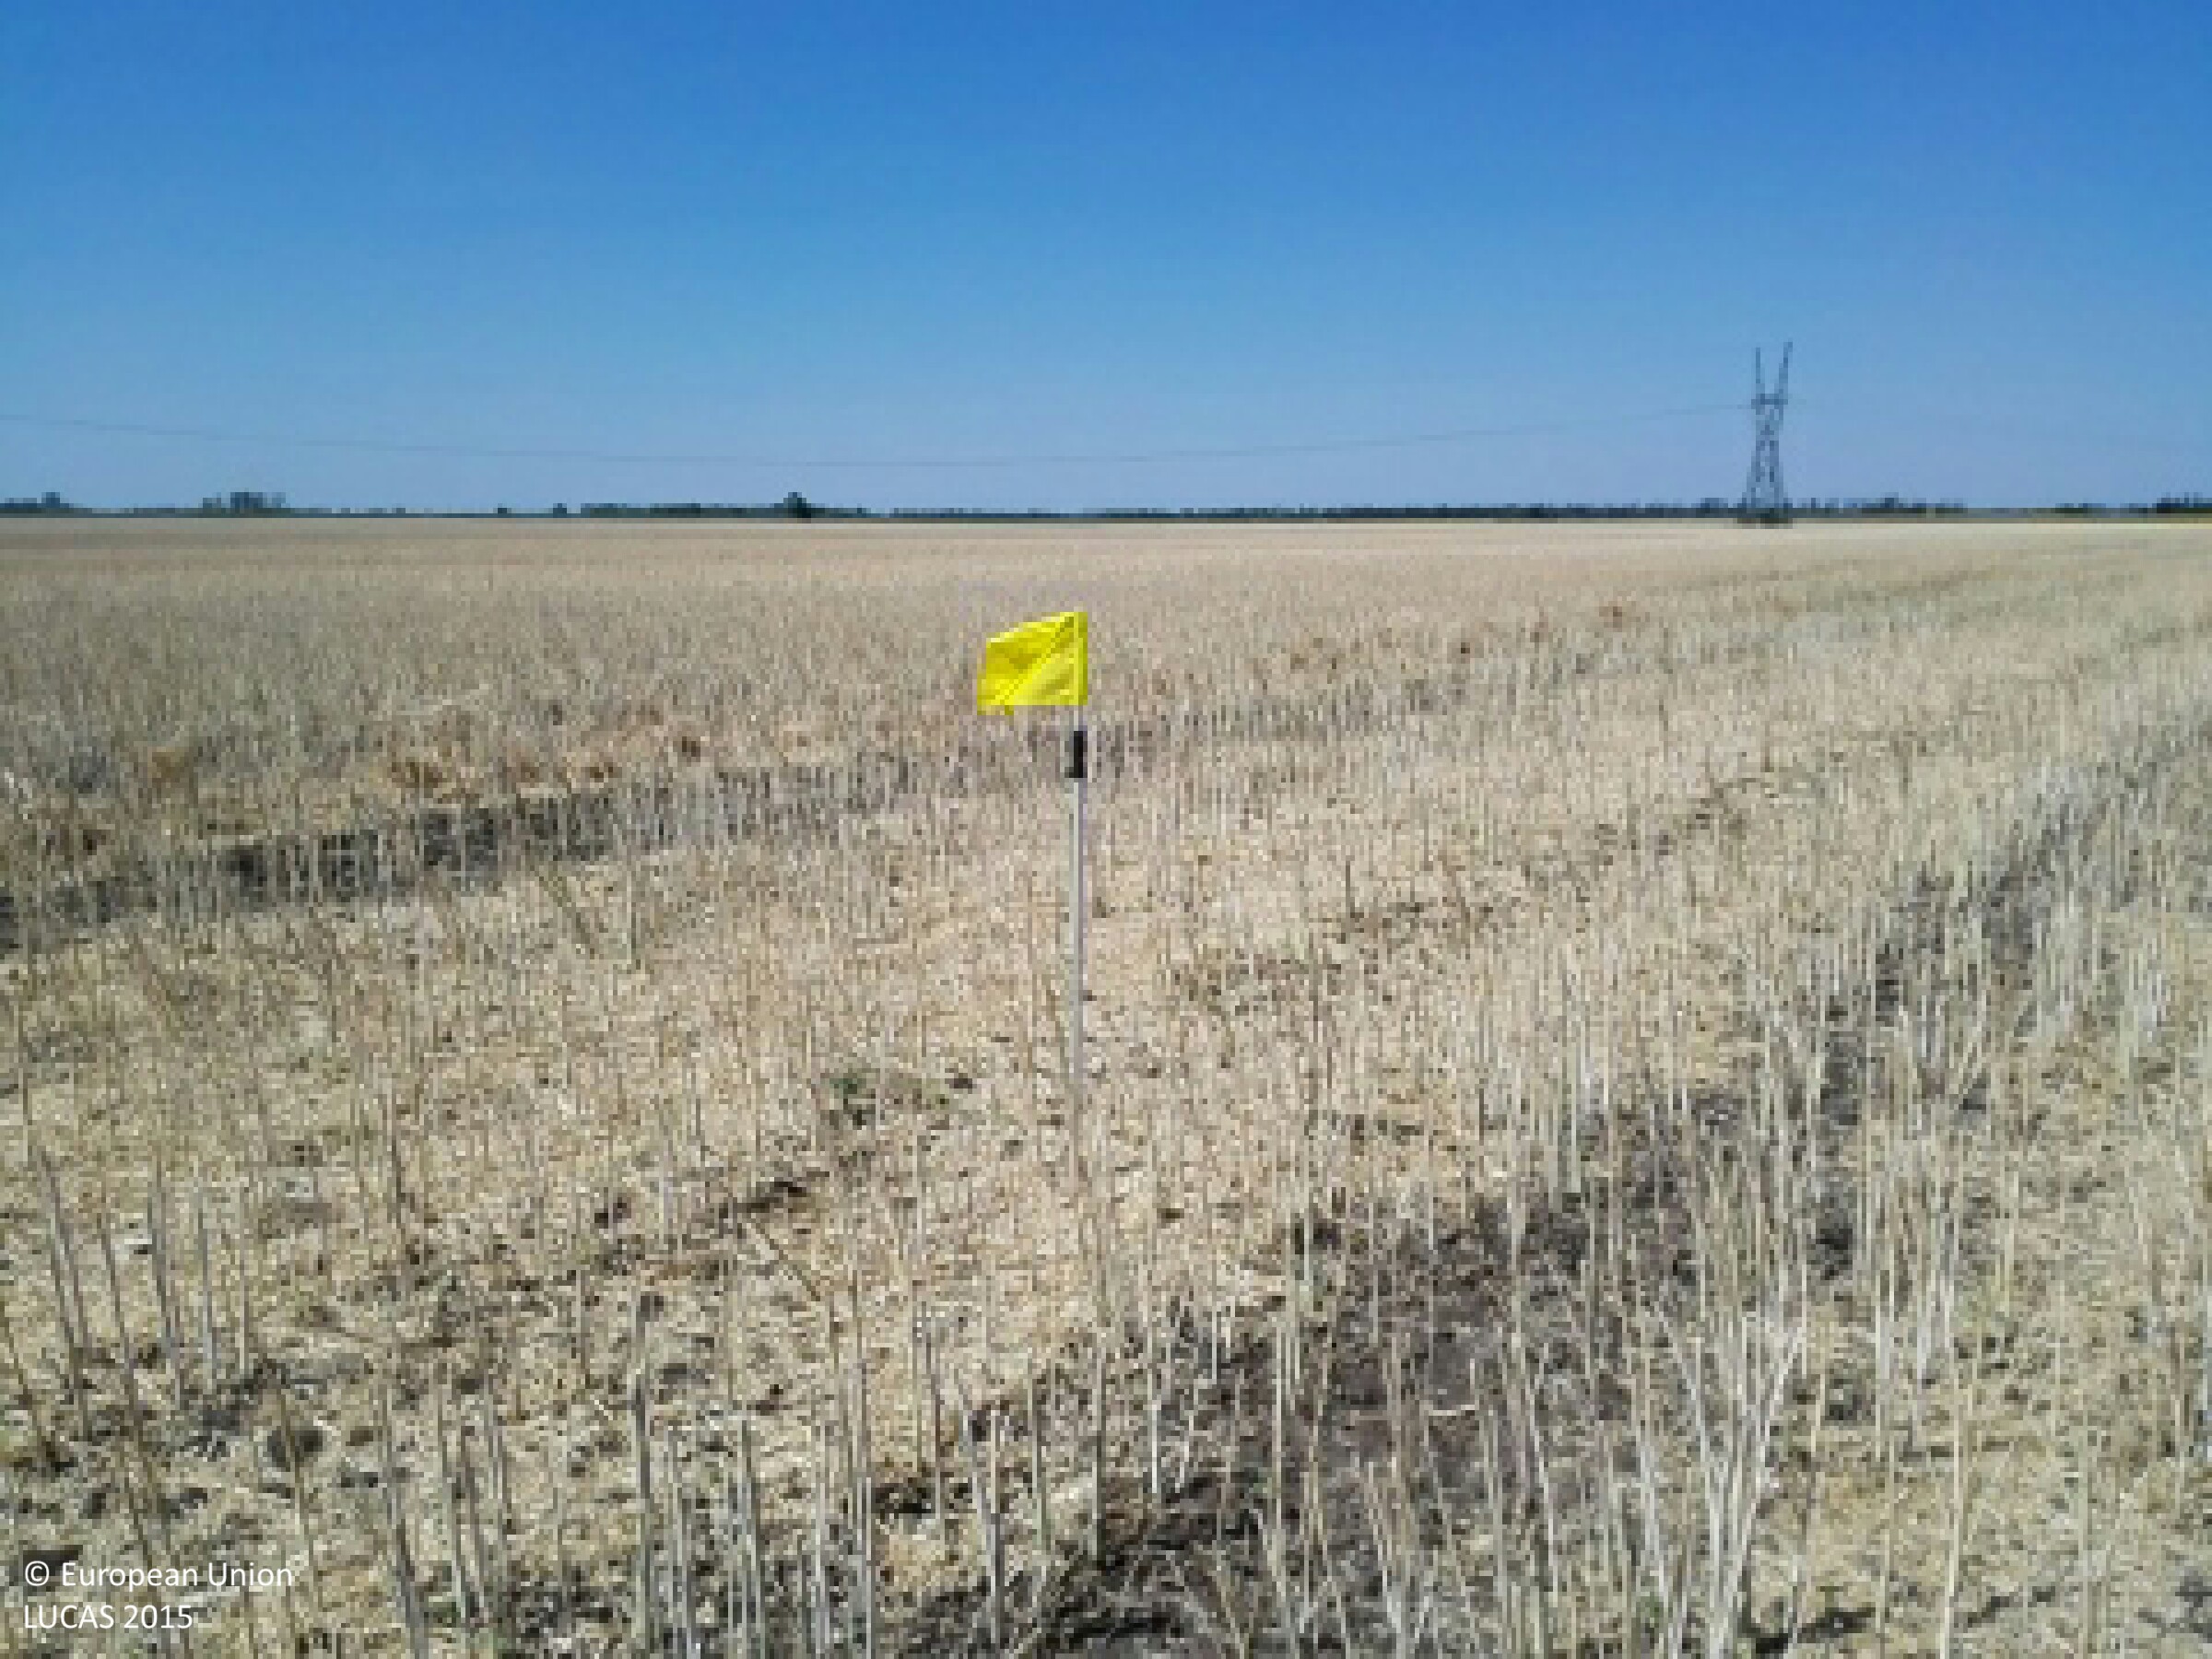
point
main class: Cropland
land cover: Rape and turnip rape
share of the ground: > 75 %
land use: Agriculture (excluding fallow land and kitchen gardens)
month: July
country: HU
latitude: 47.7522
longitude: 21.4482
